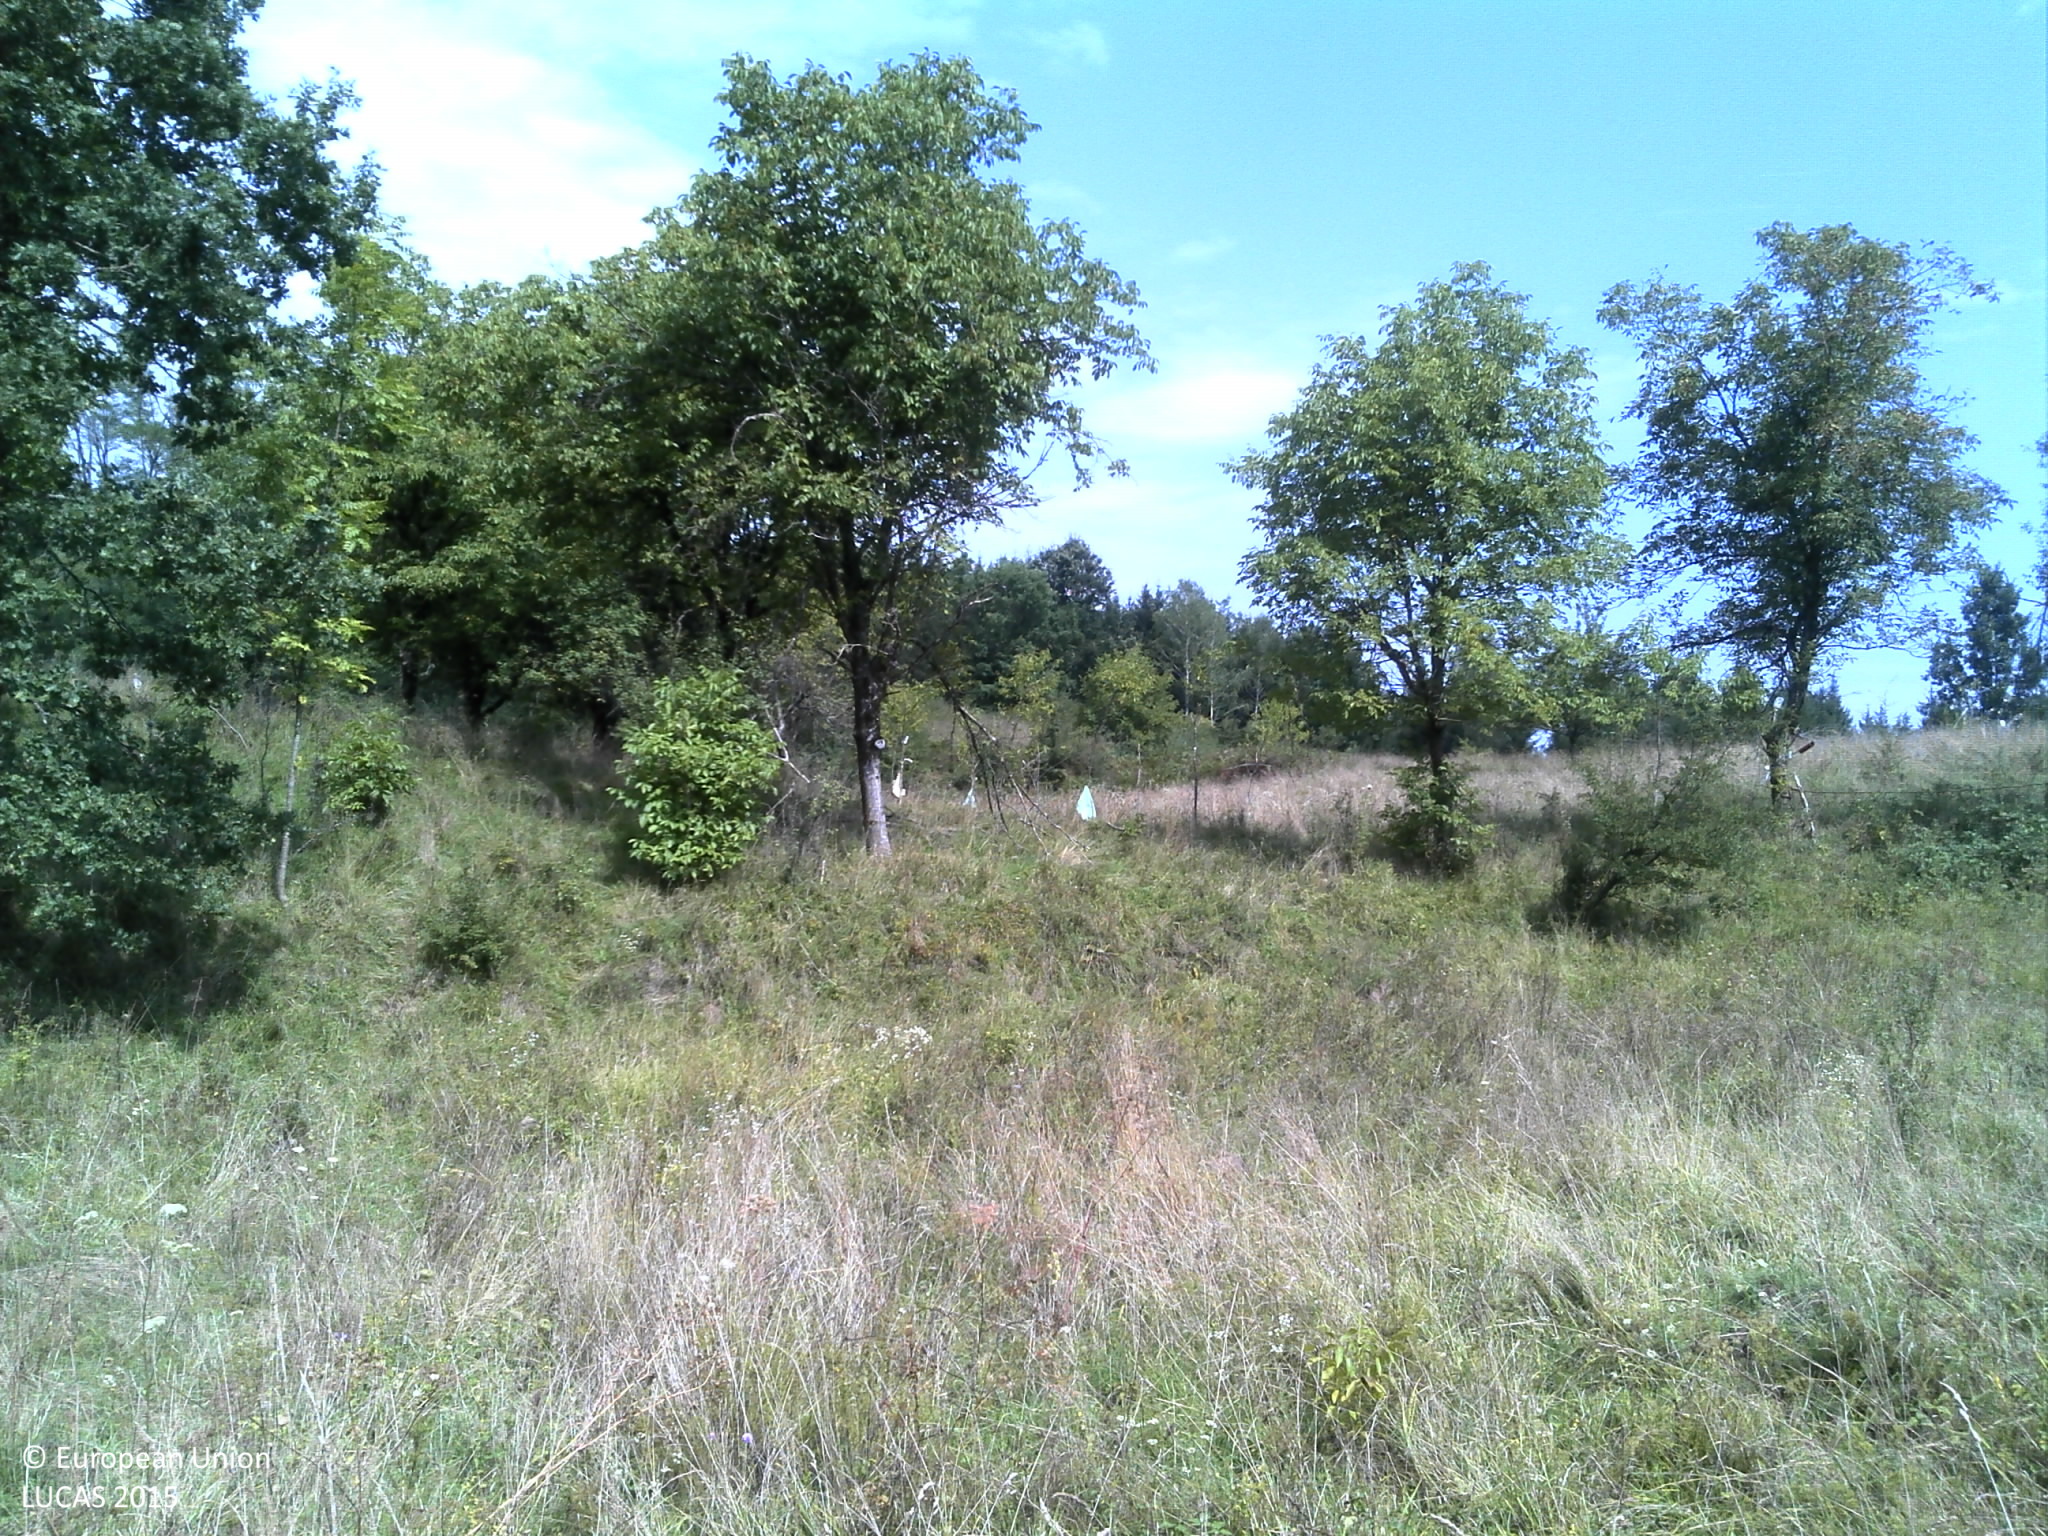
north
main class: Cropland
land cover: Lucerne
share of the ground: > 75 %
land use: Agriculture (excluding fallow land and kitchen gardens)
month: September
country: HR
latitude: 45.4460
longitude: 15.2506
